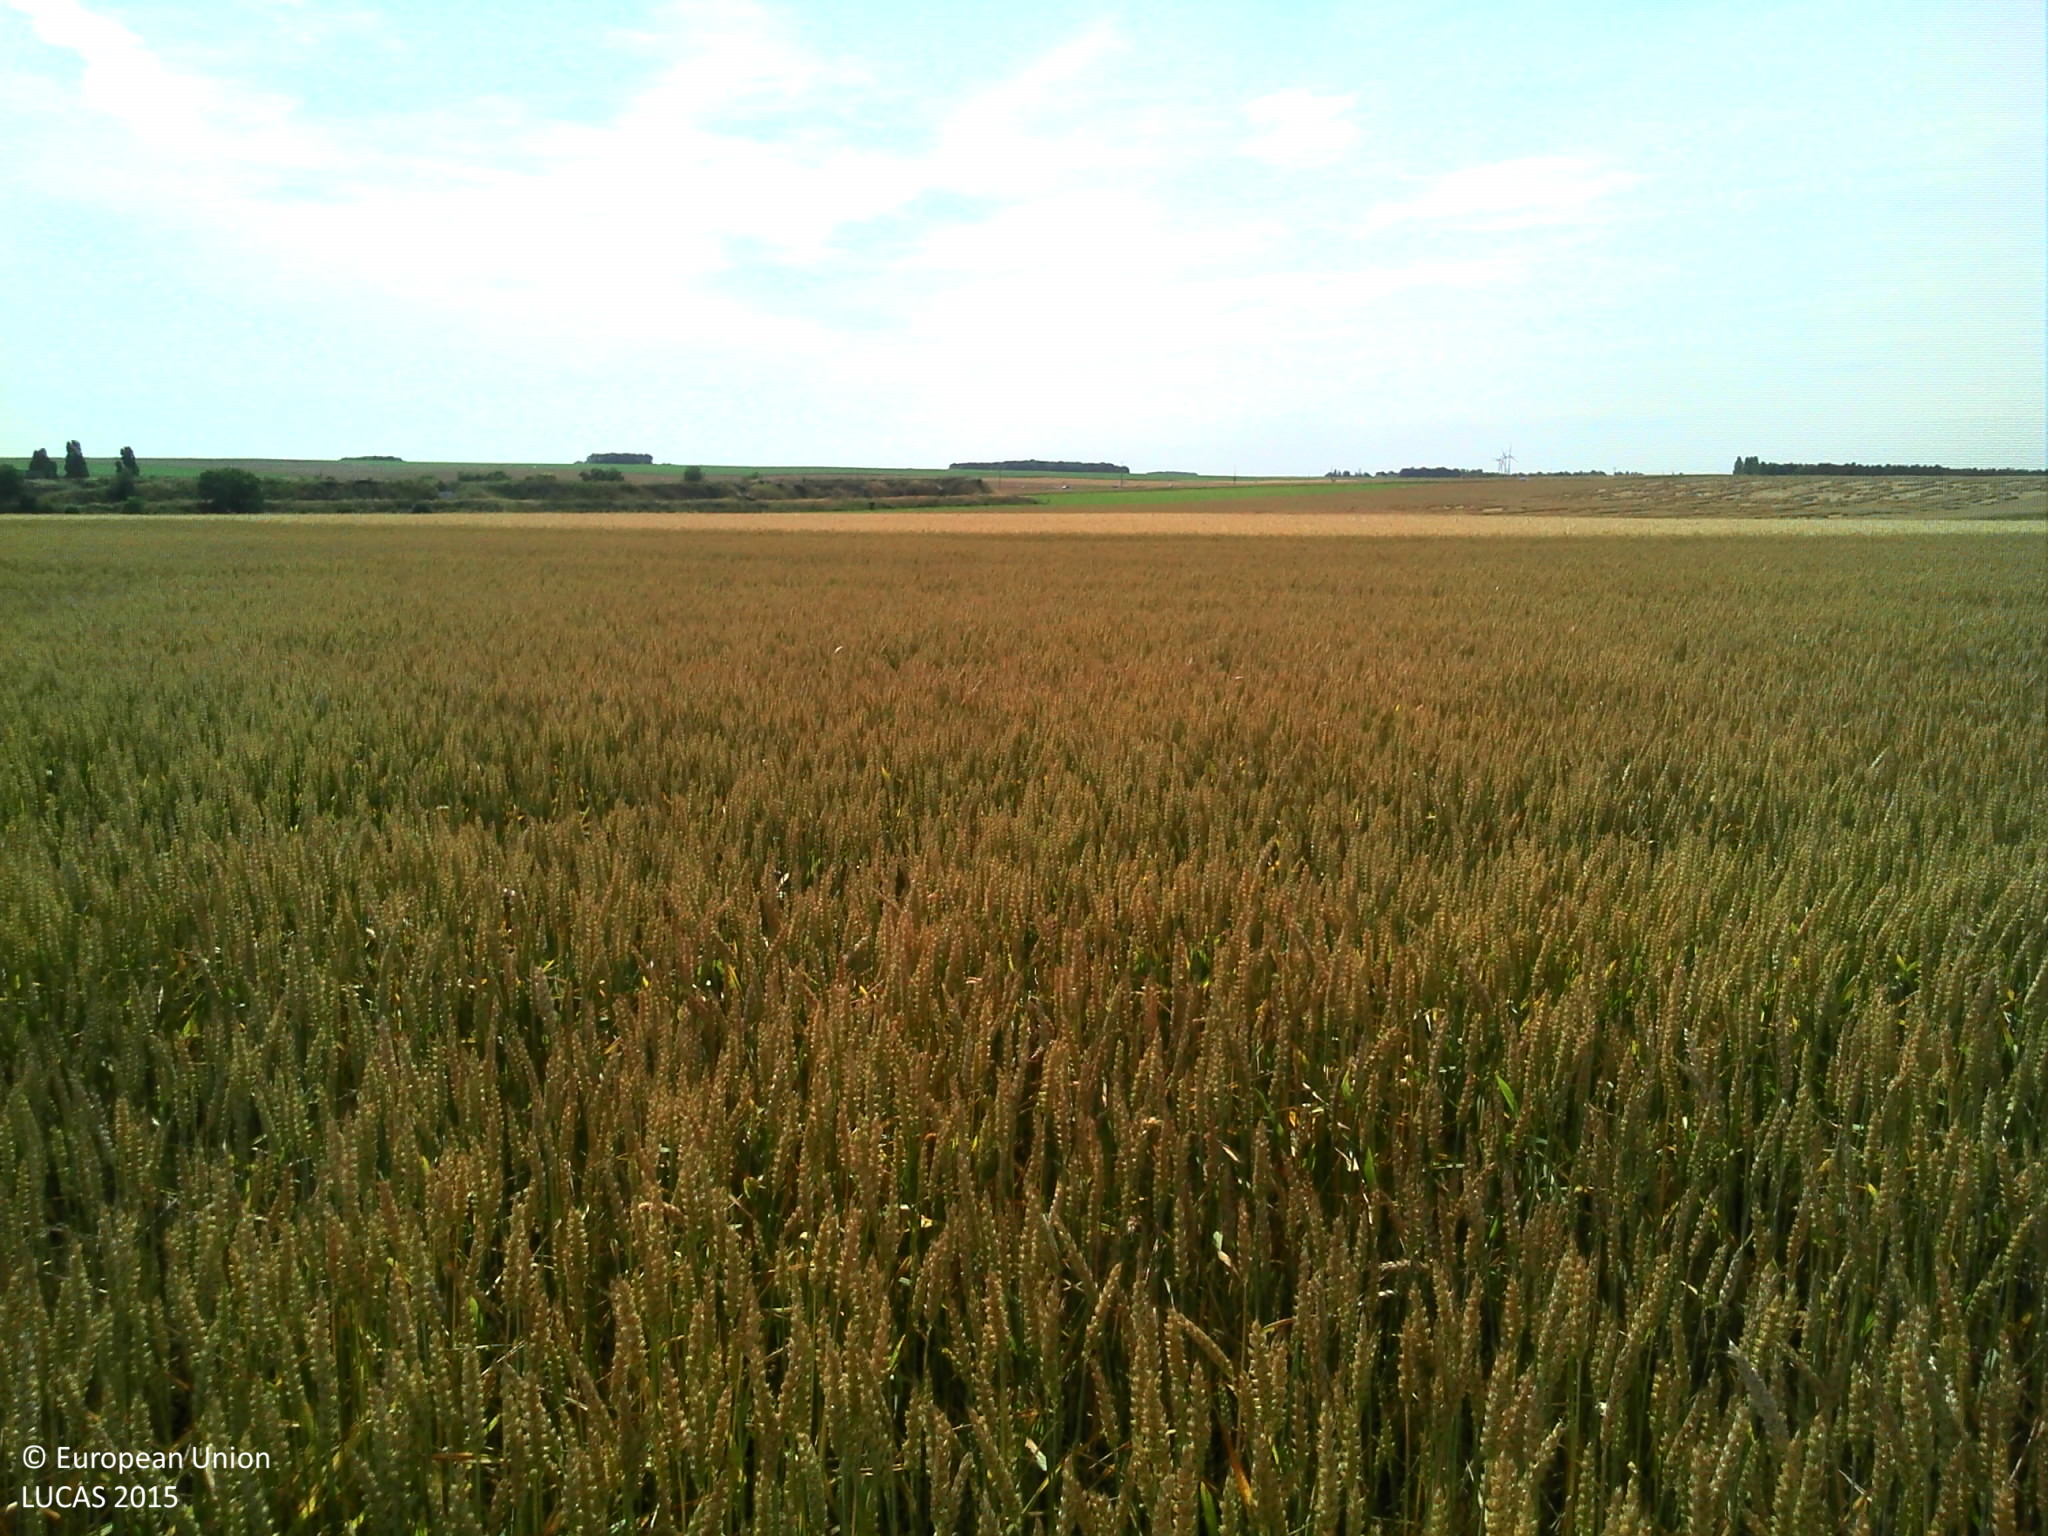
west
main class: Cropland
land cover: Common wheat
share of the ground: > 75 %
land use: Agriculture (excluding fallow land and kitchen gardens)
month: June
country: FR
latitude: 46.6634
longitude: 0.2166
